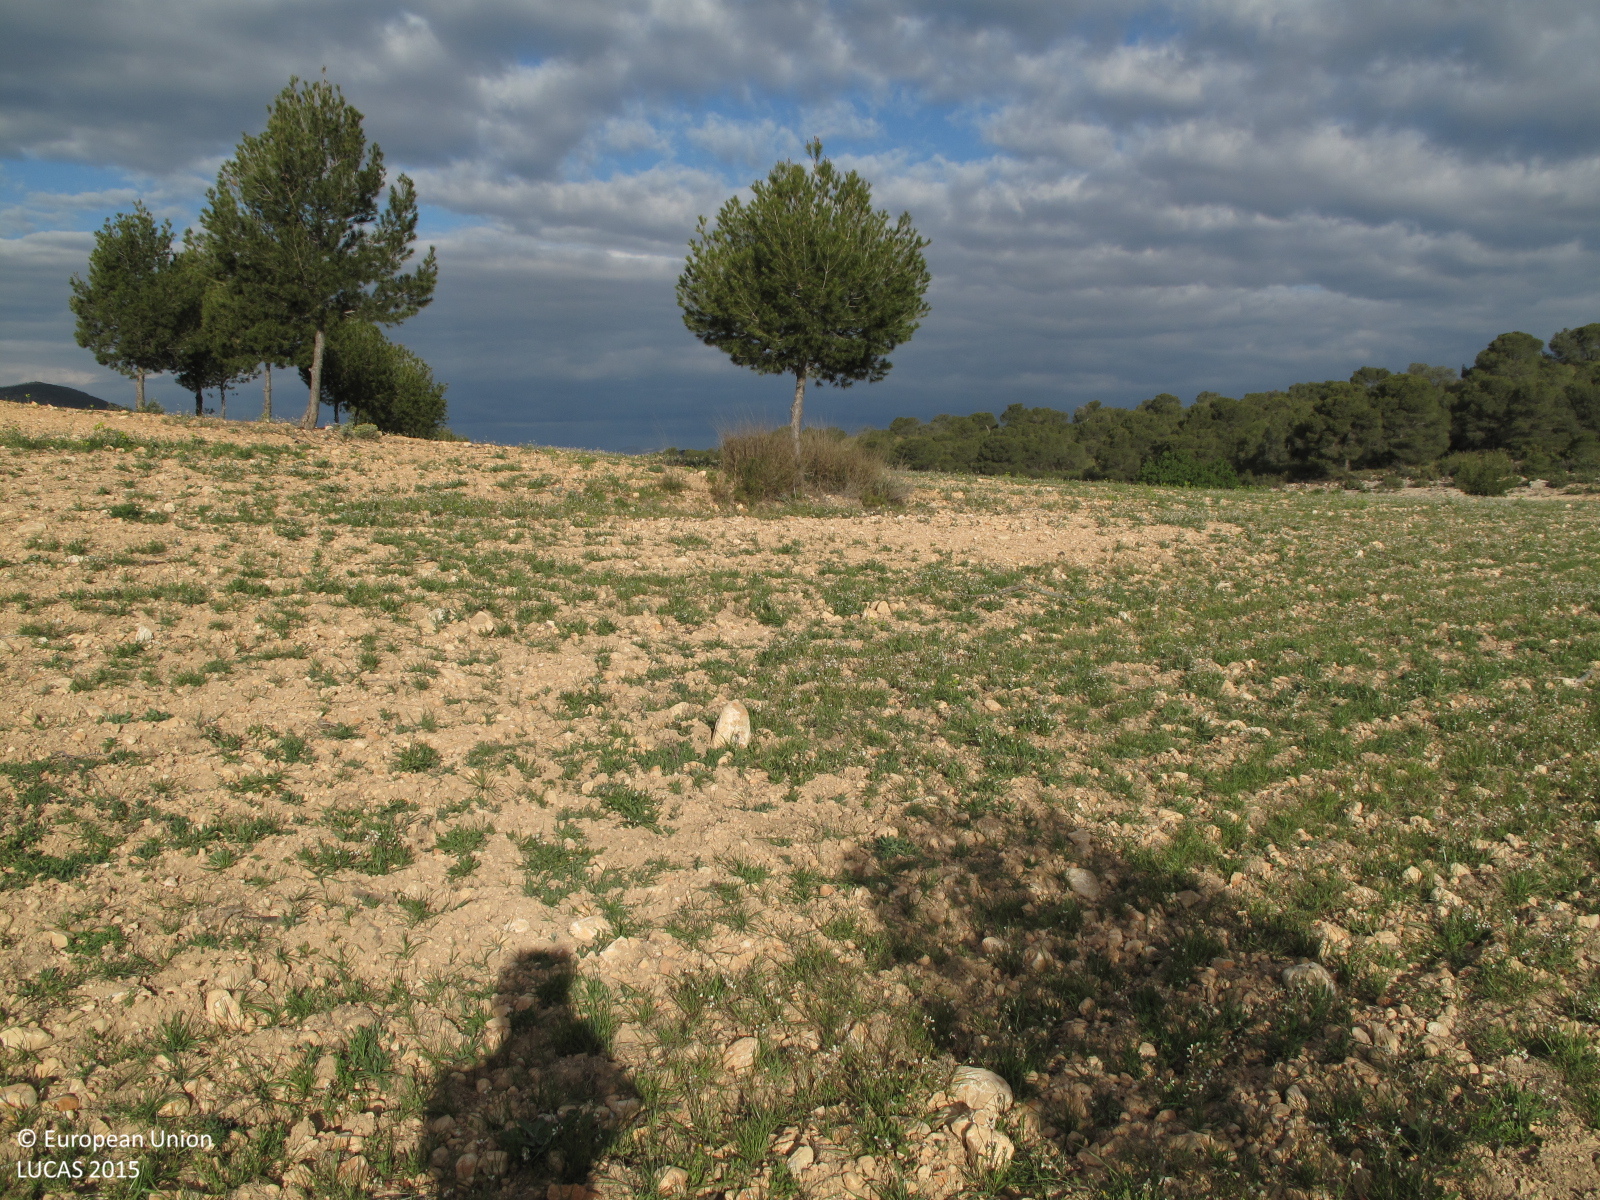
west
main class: Grassland
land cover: Spontaneously vegetated surfaces
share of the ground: > 75 %
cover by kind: herbaceous plants 80 %, unconsolidated bare surface 20 %
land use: Fallow land
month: April
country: ES
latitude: 38.4726
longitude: -1.0501
